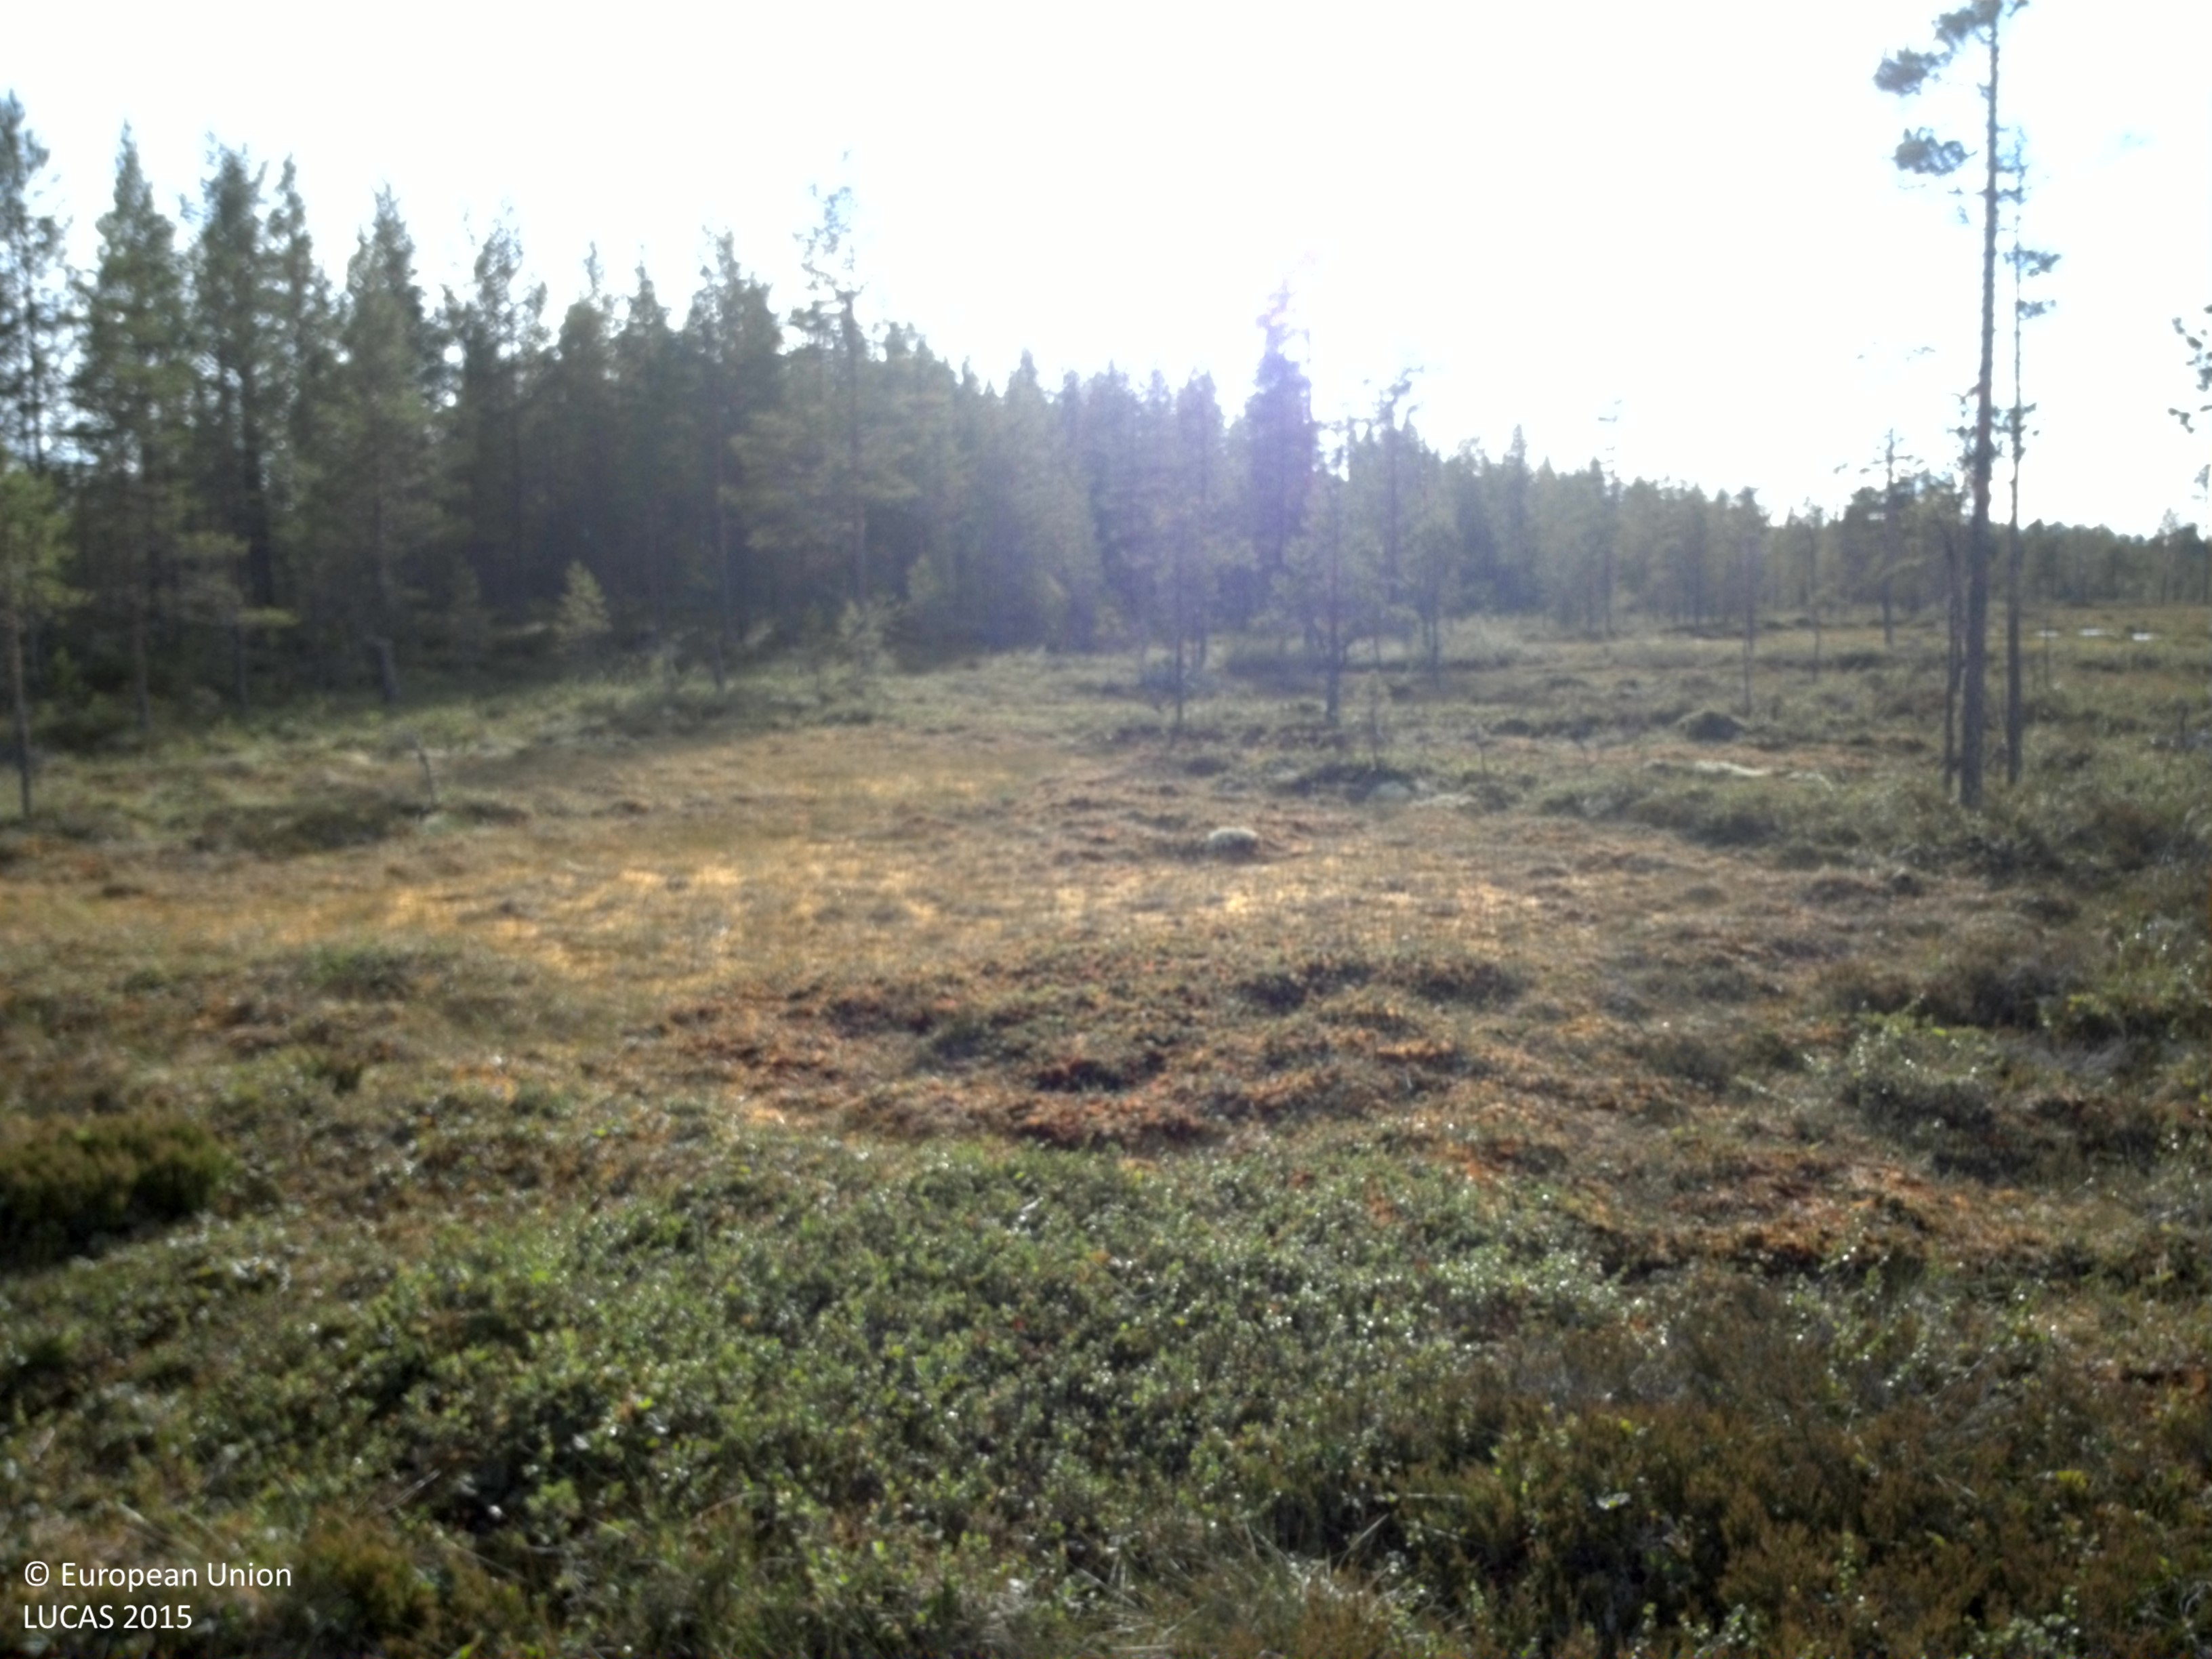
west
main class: Woodland
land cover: Pine dominated coniferous woodland
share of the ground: 10 - 25 %
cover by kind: lichens and mosses 40 %, shrubs 30 %, coniferous forest trees 20 %, herbaceous plants 10 %
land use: Semi-natural and natural areas not in use
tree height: < 5 m
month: July
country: SE
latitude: 61.3256
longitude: 13.5559
